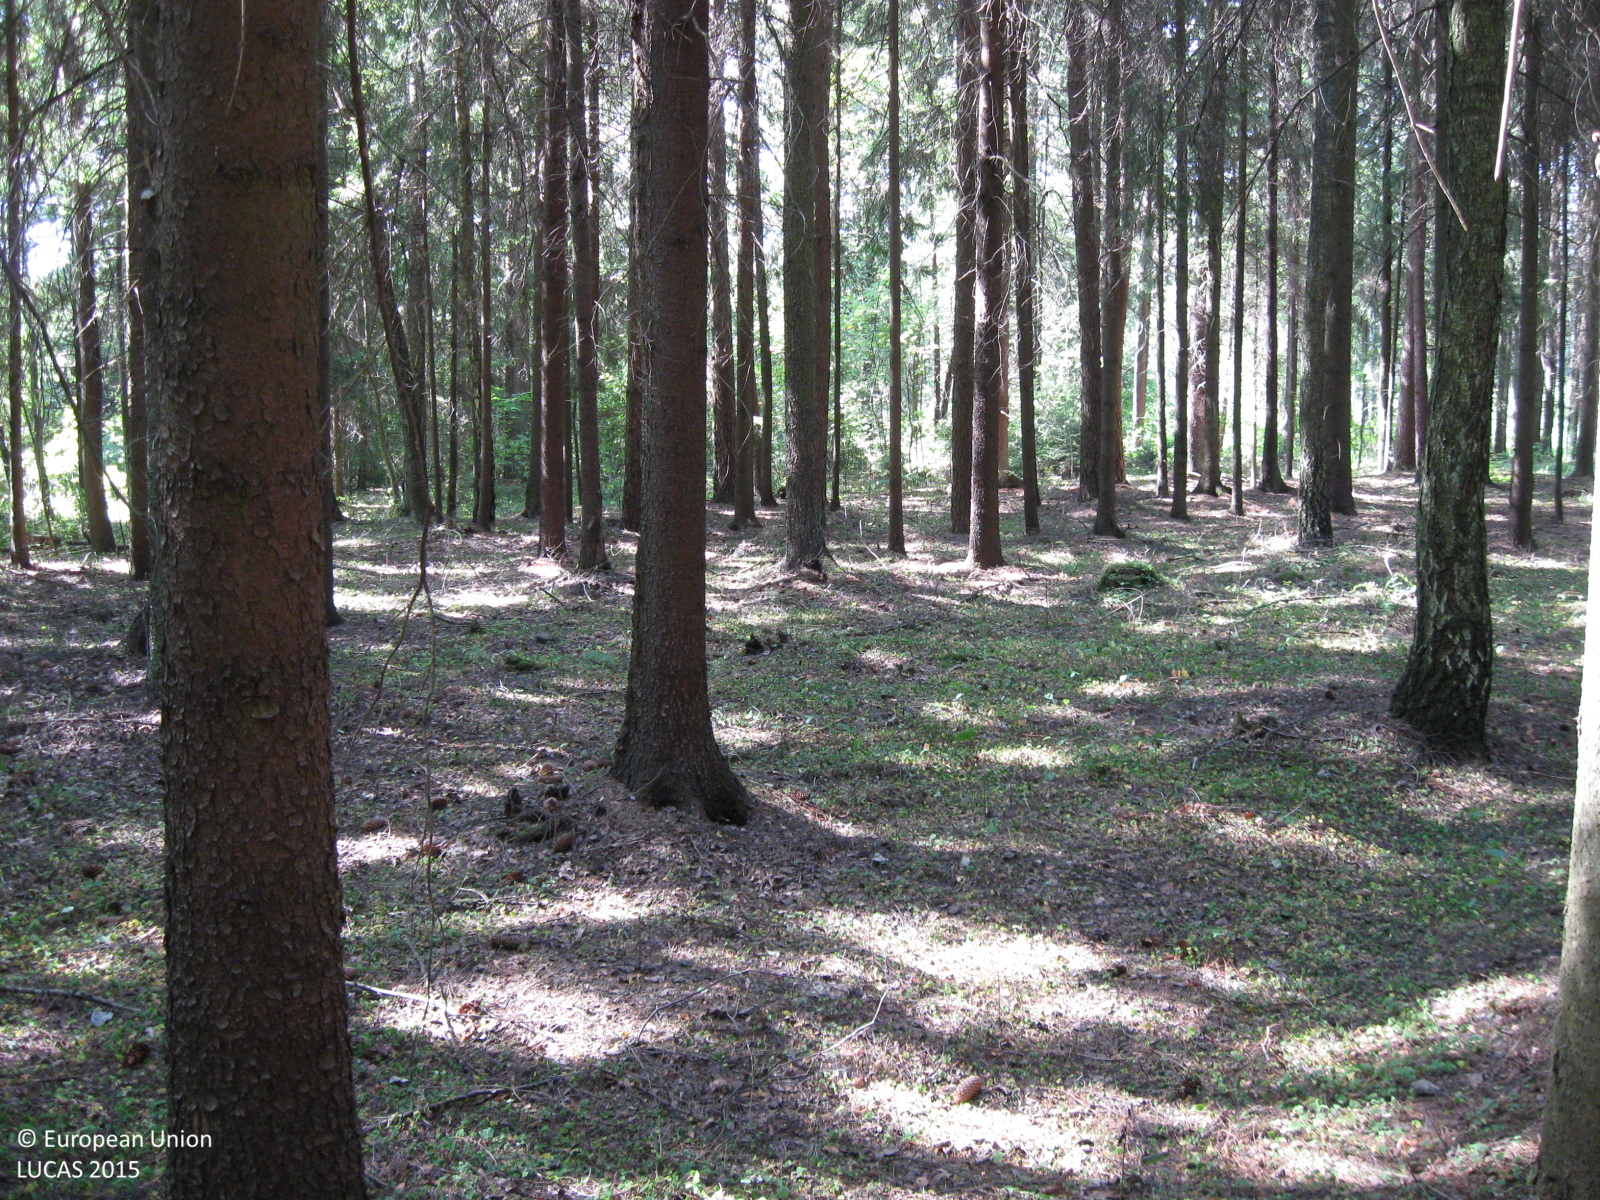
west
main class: Woodland
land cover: Spruce dominated coniferous woodland
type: hemiboreal forest and nemoral coniferous forest and mixed broadleaved-coniferous forest
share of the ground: > 75 %
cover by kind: coniferous forest trees 85 %, broadleaved forest trees 10 %, herbaceous plants 5 %
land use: Forestry
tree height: > 5 m
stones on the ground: < 10 %
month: August
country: LT
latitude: 55.2660
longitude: 22.4782
